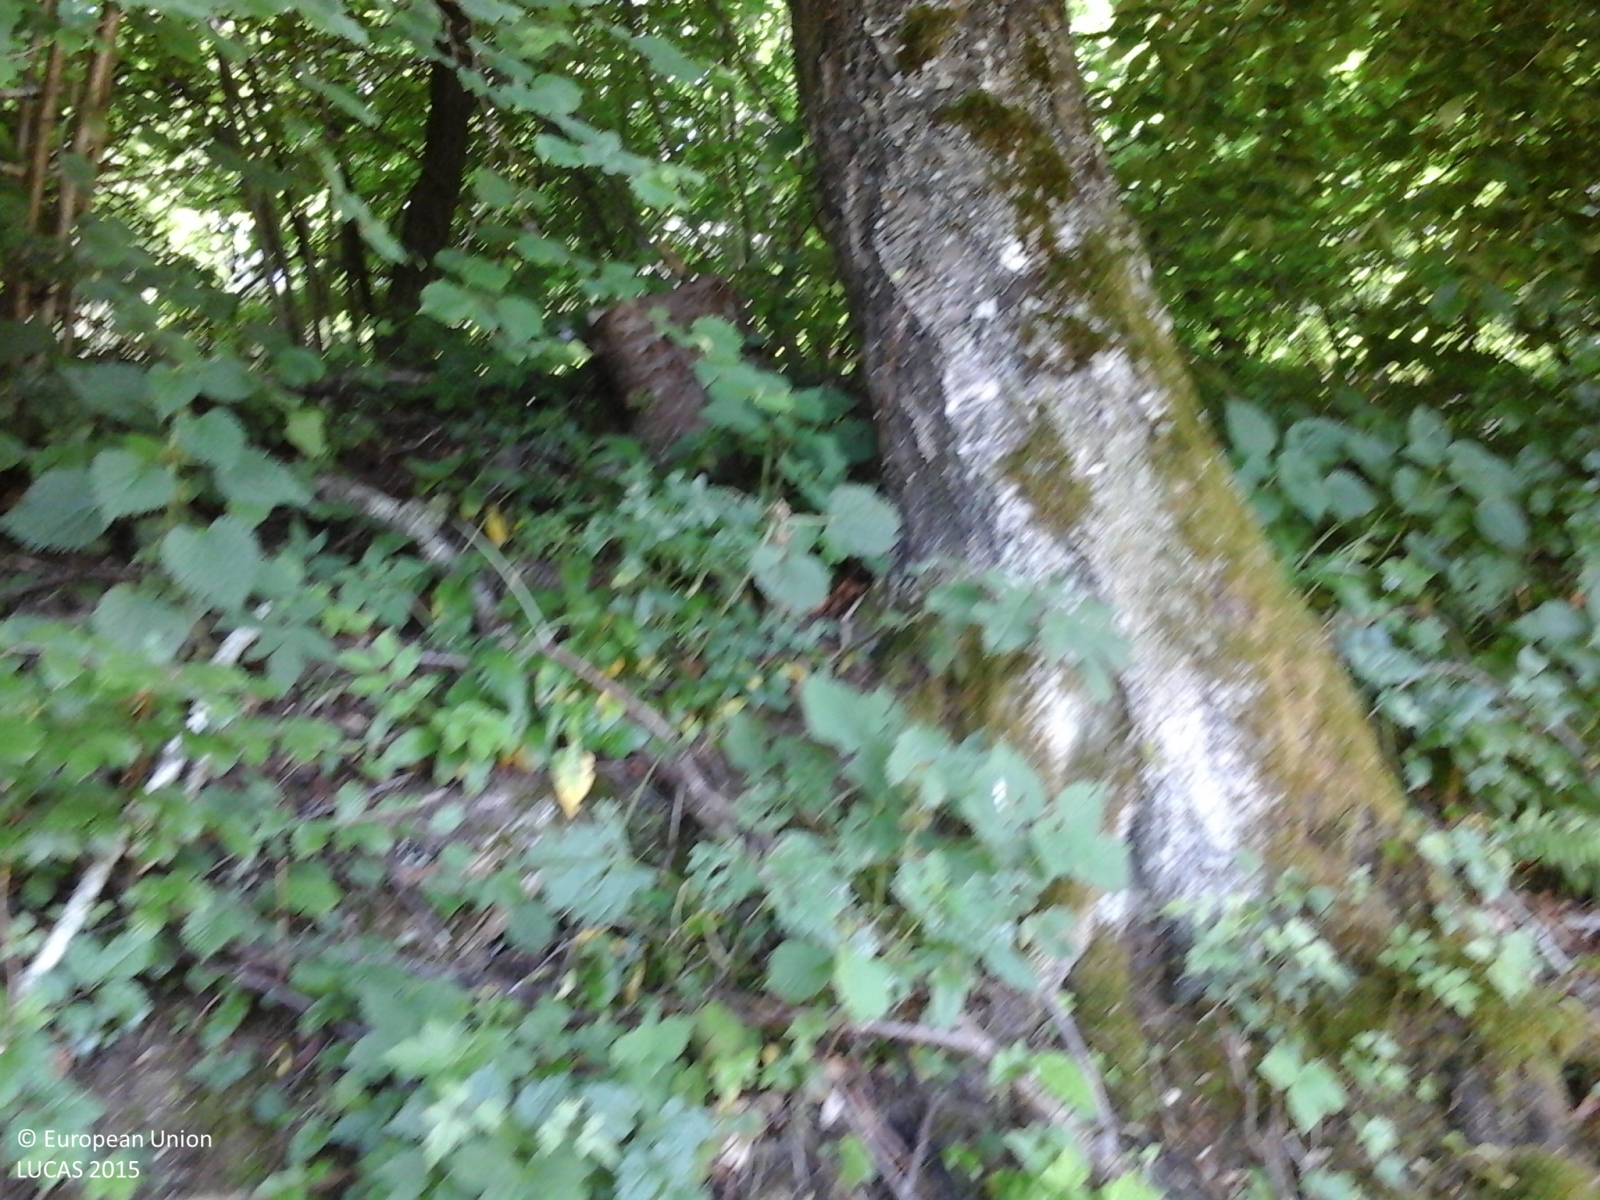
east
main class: Woodland
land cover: Broadleaved woodland
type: mesophytic deciduous forest
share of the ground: > 75 %
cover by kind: broadleaved forest trees 100 %
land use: Semi-natural and natural areas not in use
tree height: > 5 m
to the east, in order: Broadleaved woodland; Grassland without tree/shrub cover; Broadleaved woodland; Grassland without tree/shrub cover; Broadleaved woodland; Tracks; Lines of trees; Grassland without tree/shrub cover
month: June
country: IT
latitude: 46.0237
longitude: 12.1286
